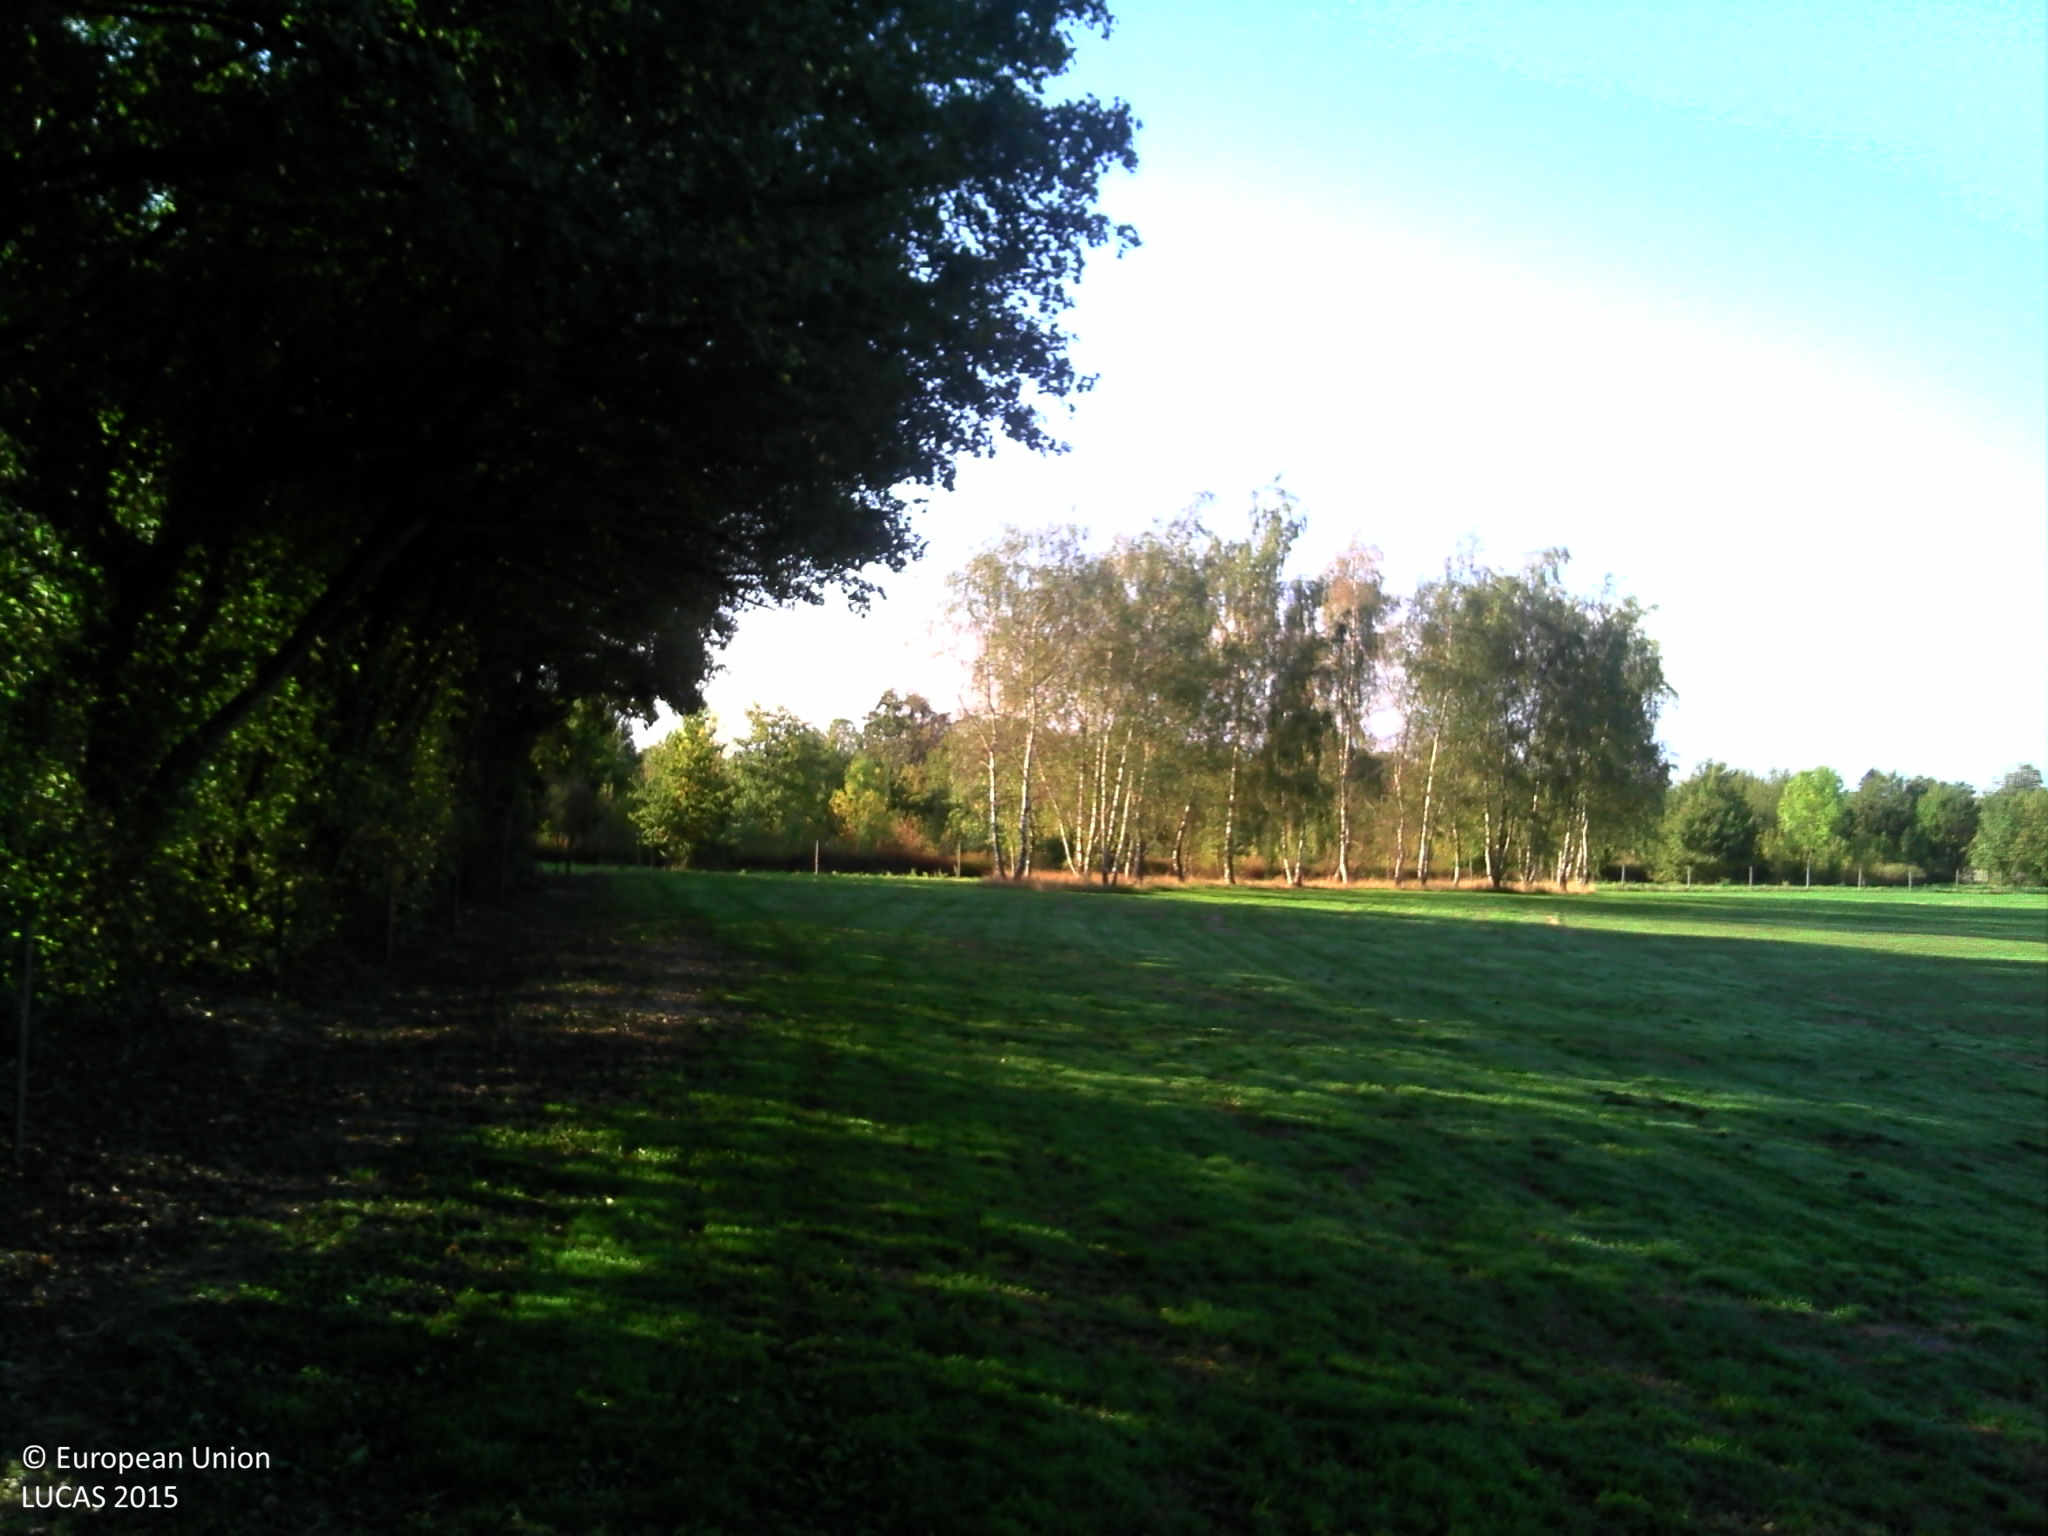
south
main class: Cropland
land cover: Temporary grasslands
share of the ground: > 75 %
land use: Agriculture (excluding fallow land and kitchen gardens)
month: October
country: FR
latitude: 45.9604
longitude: 4.9322
